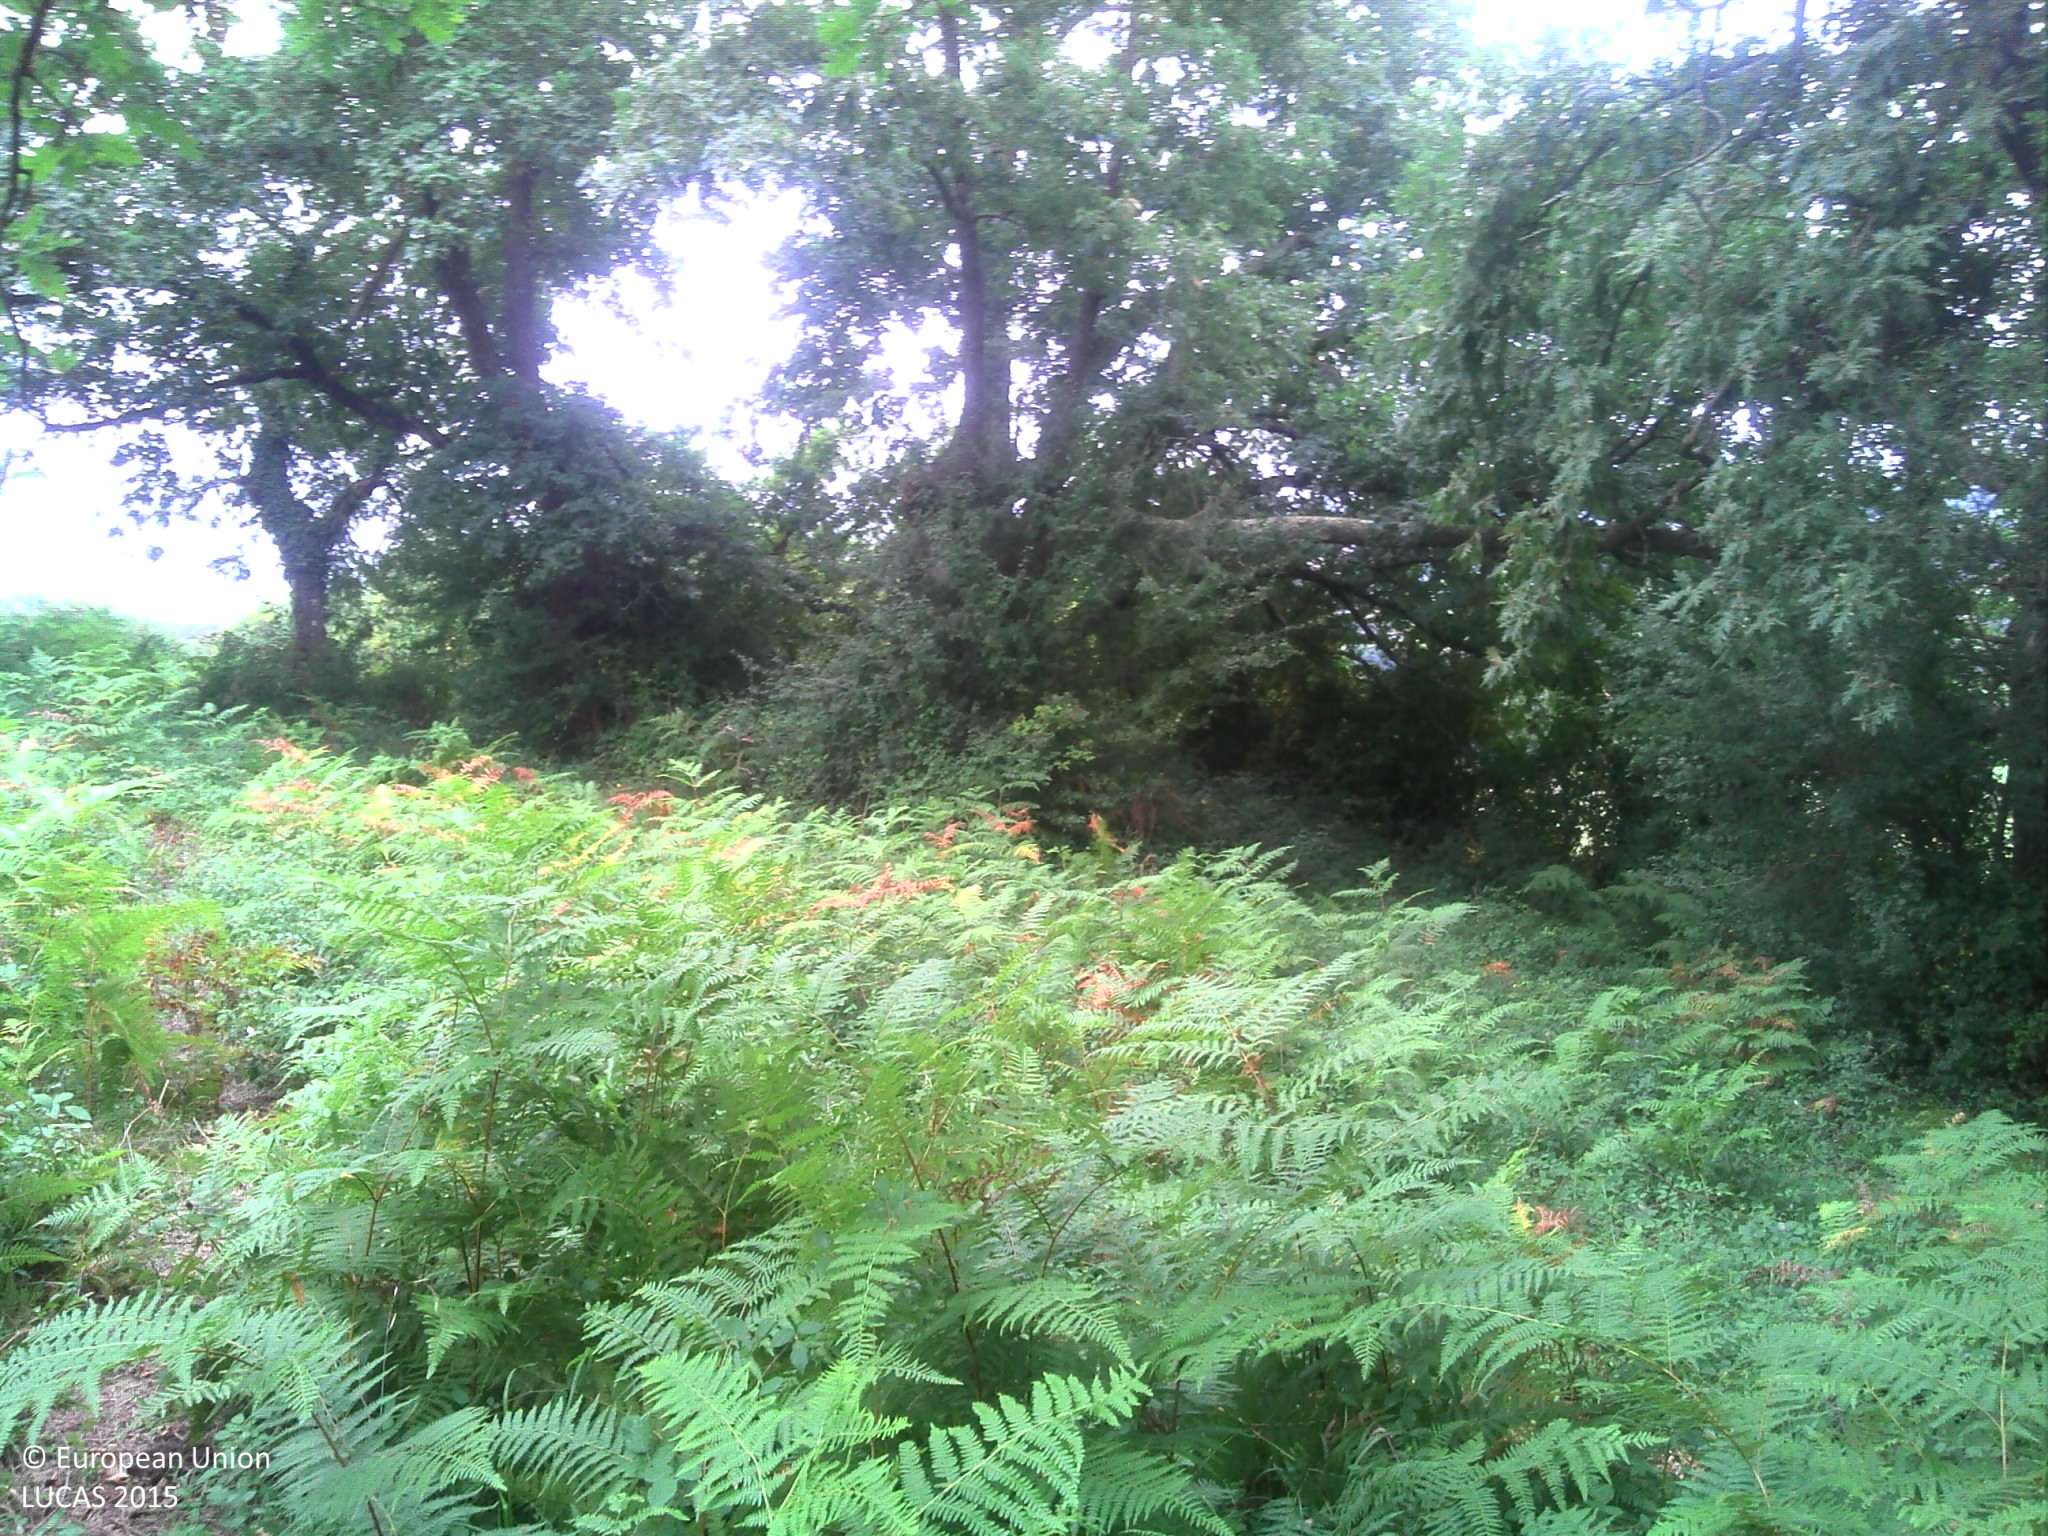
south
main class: Woodland
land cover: Broadleaved woodland
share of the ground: 10 - 25 %
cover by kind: broadleaved forest trees 100 %
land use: Forestry
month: August
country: FR
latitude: 43.2498
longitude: -1.2097
